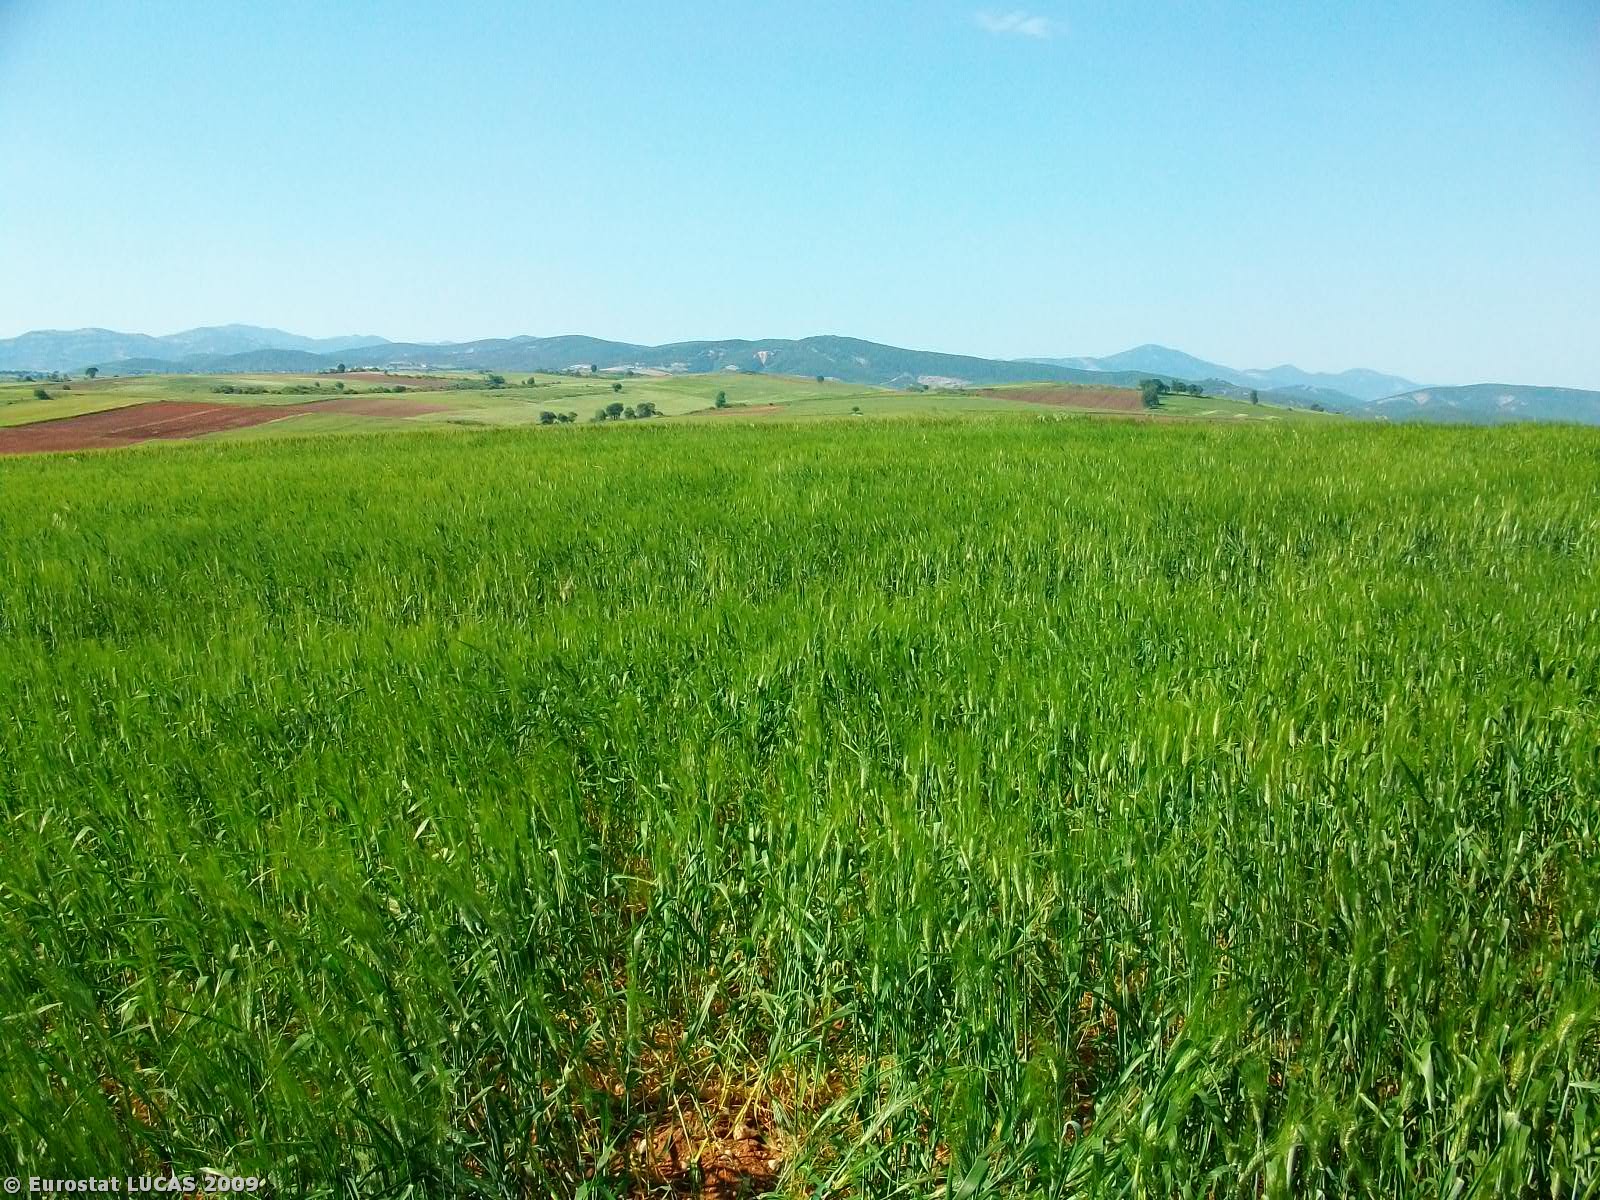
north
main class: Cropland
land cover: Durum wheat
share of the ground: > 75 %
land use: Agriculture (excluding fallow land and kitchen gardens)
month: May
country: GR
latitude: 41.1219
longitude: 25.5003
